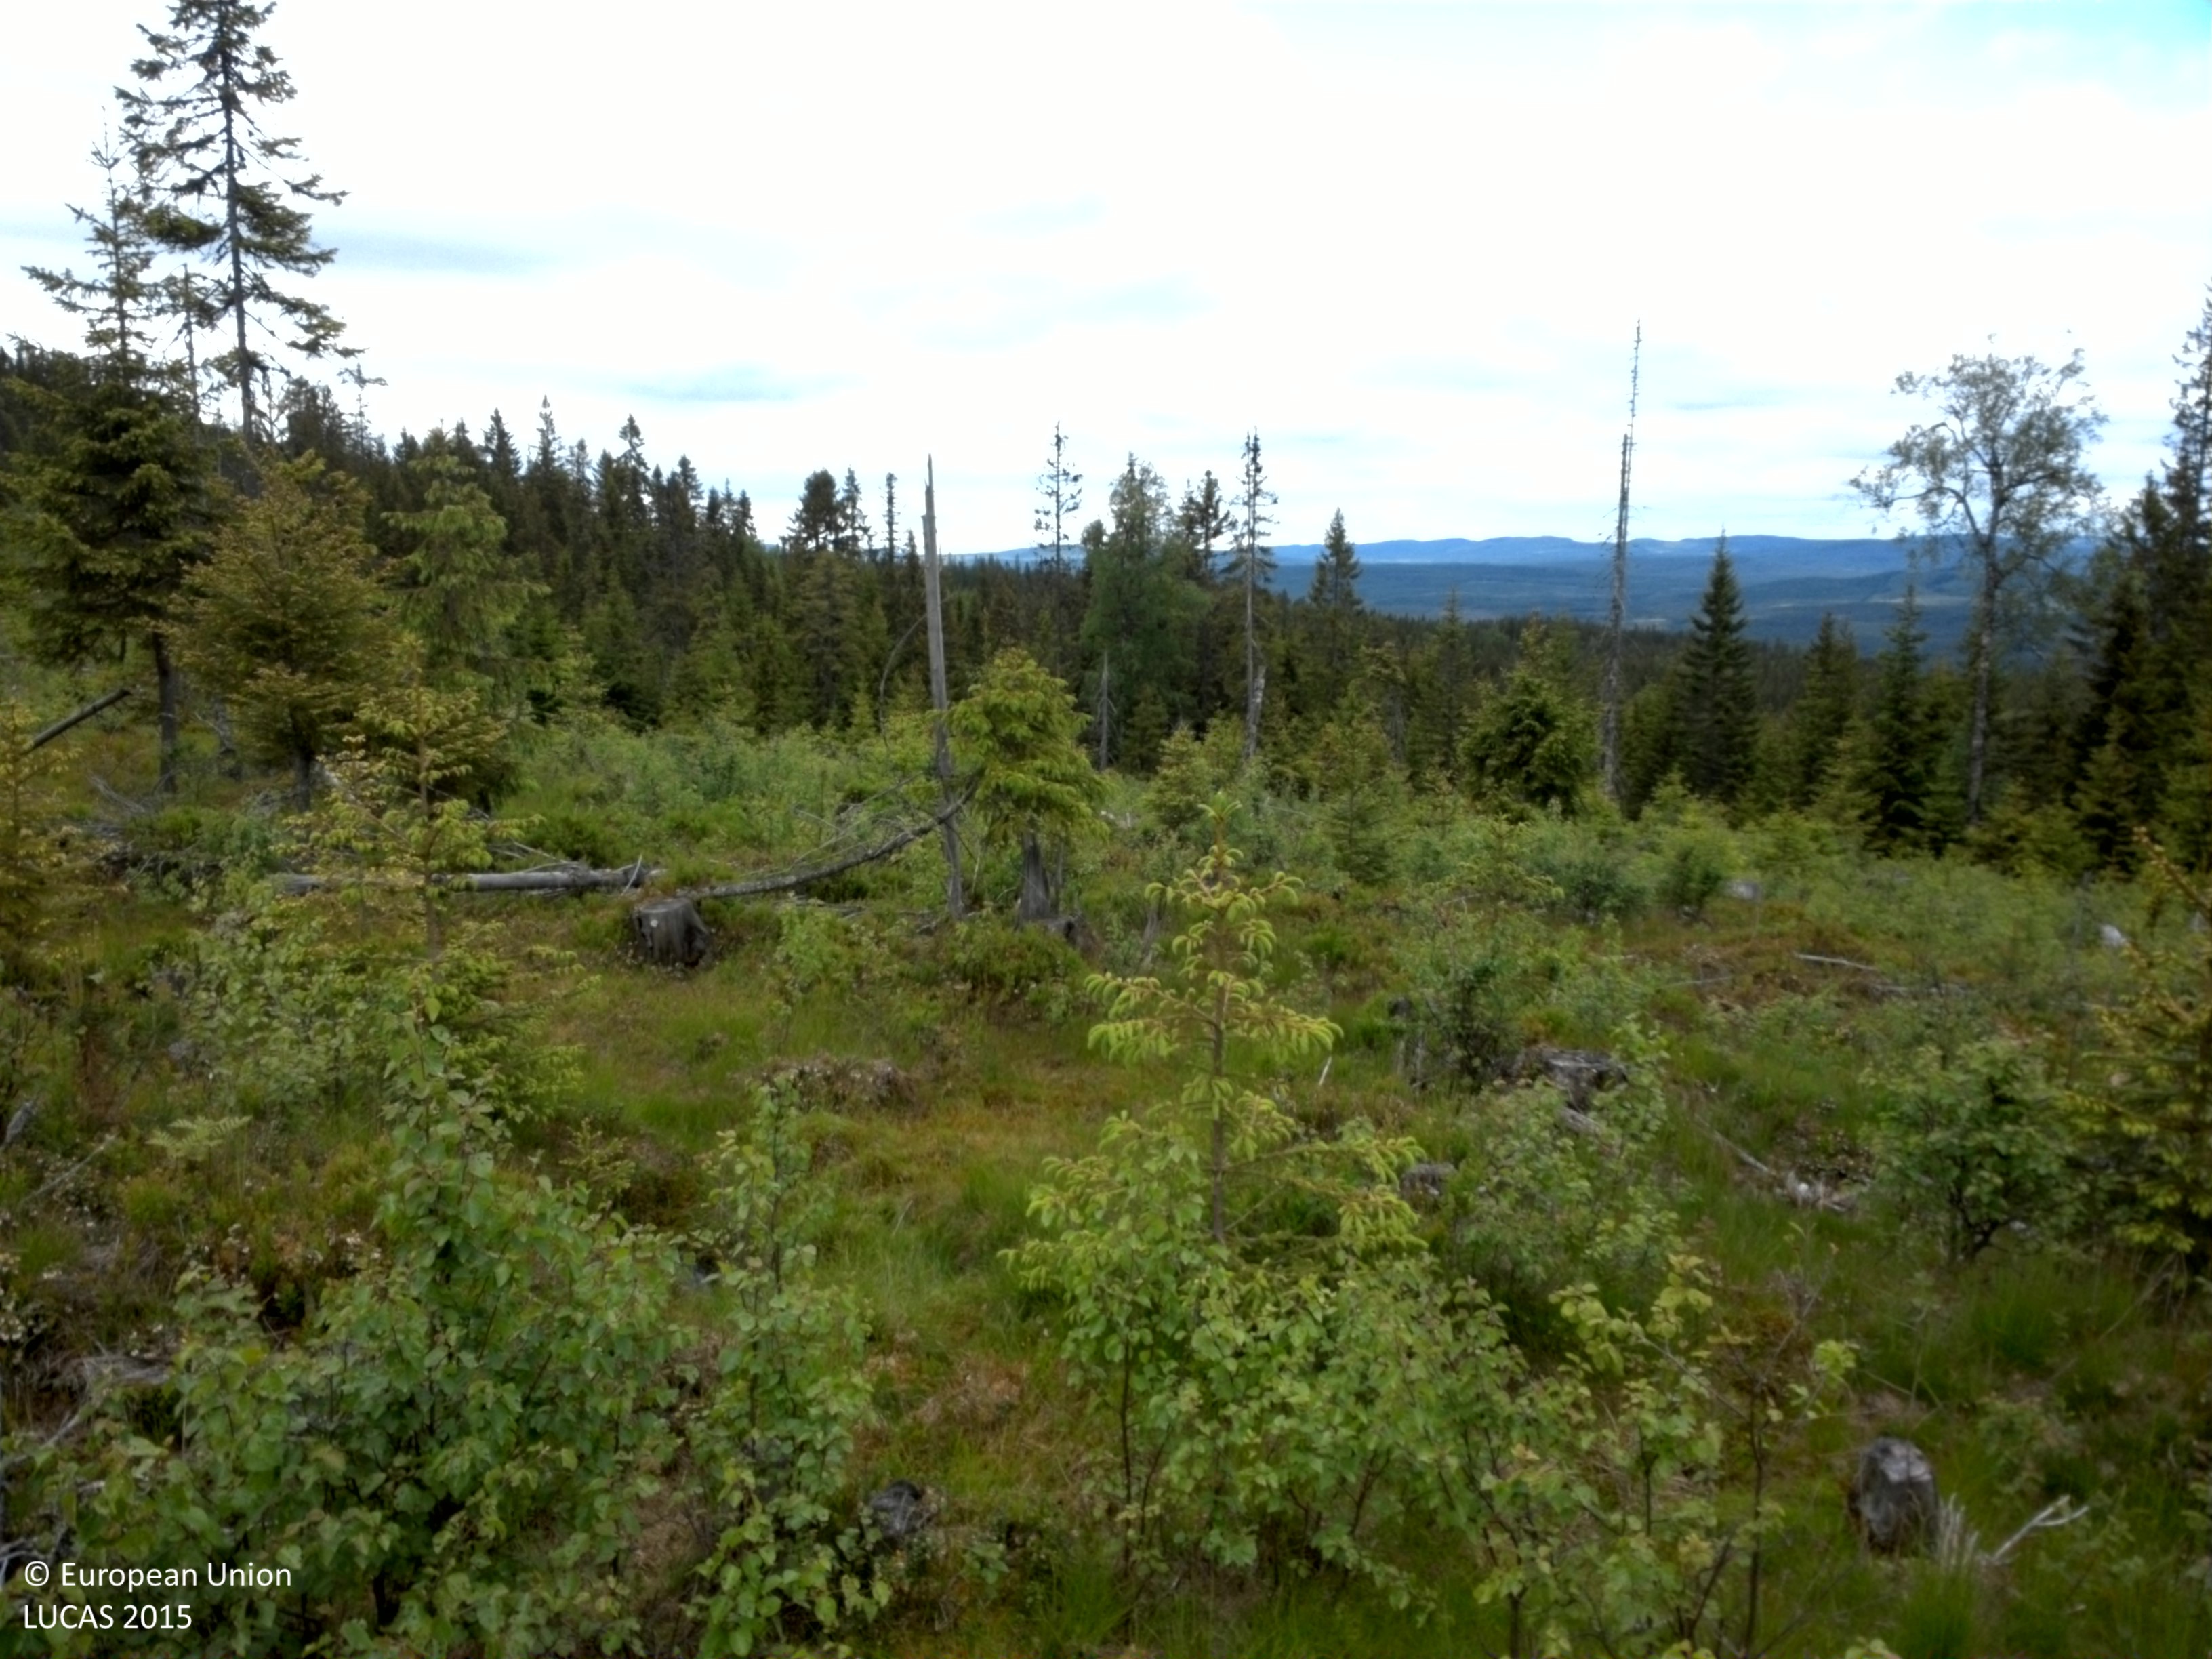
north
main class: Woodland
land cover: Spruce dominated mixed woodland
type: boreal forest
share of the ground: 10 - 25 %
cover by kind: herbaceous plants 65 %, shrubs 15 %, broadleaved forest trees 10 %, coniferous forest trees 5 %, lichens and mosses 5 %
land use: Forestry
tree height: < 5 m
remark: Clear cut
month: June
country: SE
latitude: 60.6628
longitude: 12.4985
